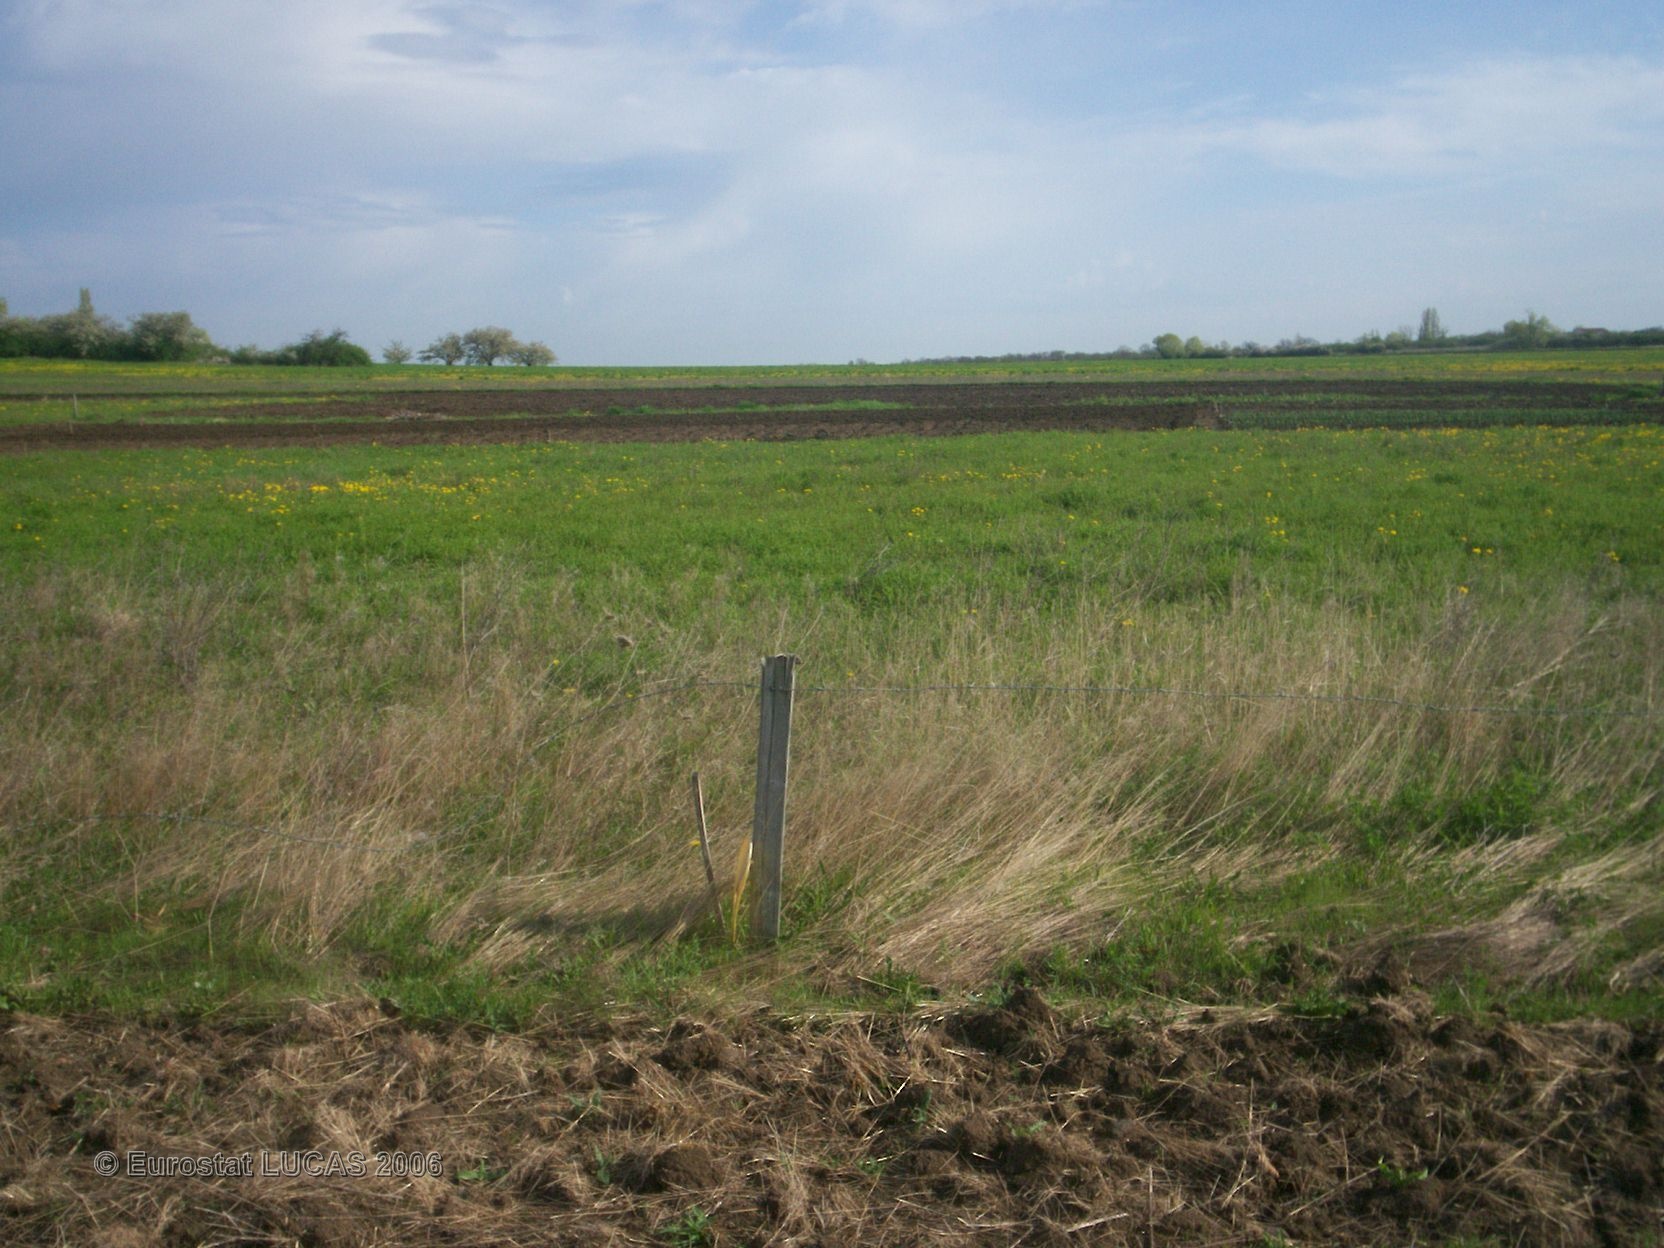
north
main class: Grassland
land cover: Grassland without tree/shrub cover
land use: Fallow land
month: April
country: FR
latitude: 45.8561
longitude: 3.0834
